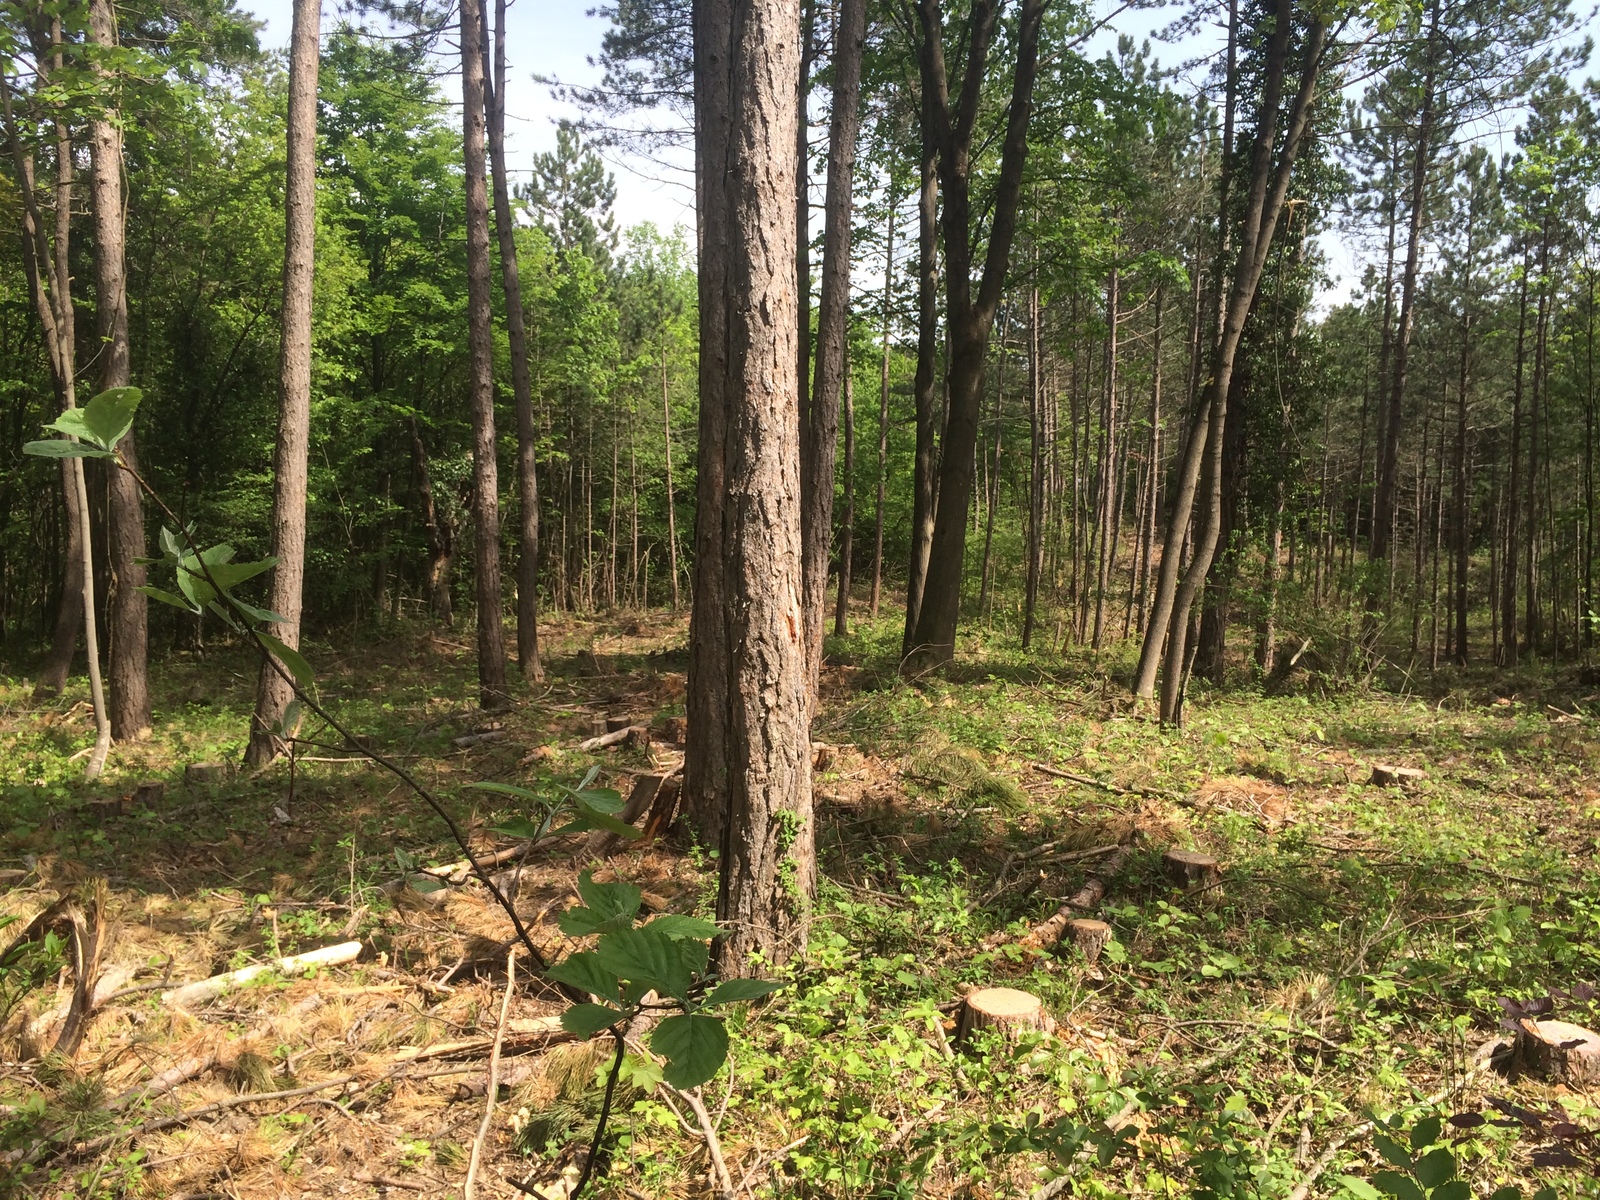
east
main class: Woodland
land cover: Pine dominated mixed woodland
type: alpine coniferous forest
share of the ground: > 75 %
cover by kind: coniferous forest trees 40 %, broadleaved forest trees 40 %, shrubs 10 %, herbaceous plants 10 %
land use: Forestry
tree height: > 5 m
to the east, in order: Pine dominated mixed woodland; Broadleaved woodland; Pine dominated mixed woodland; Broadleaved woodland; Tracks
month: May
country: AT
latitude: 47.9242
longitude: 16.1733
